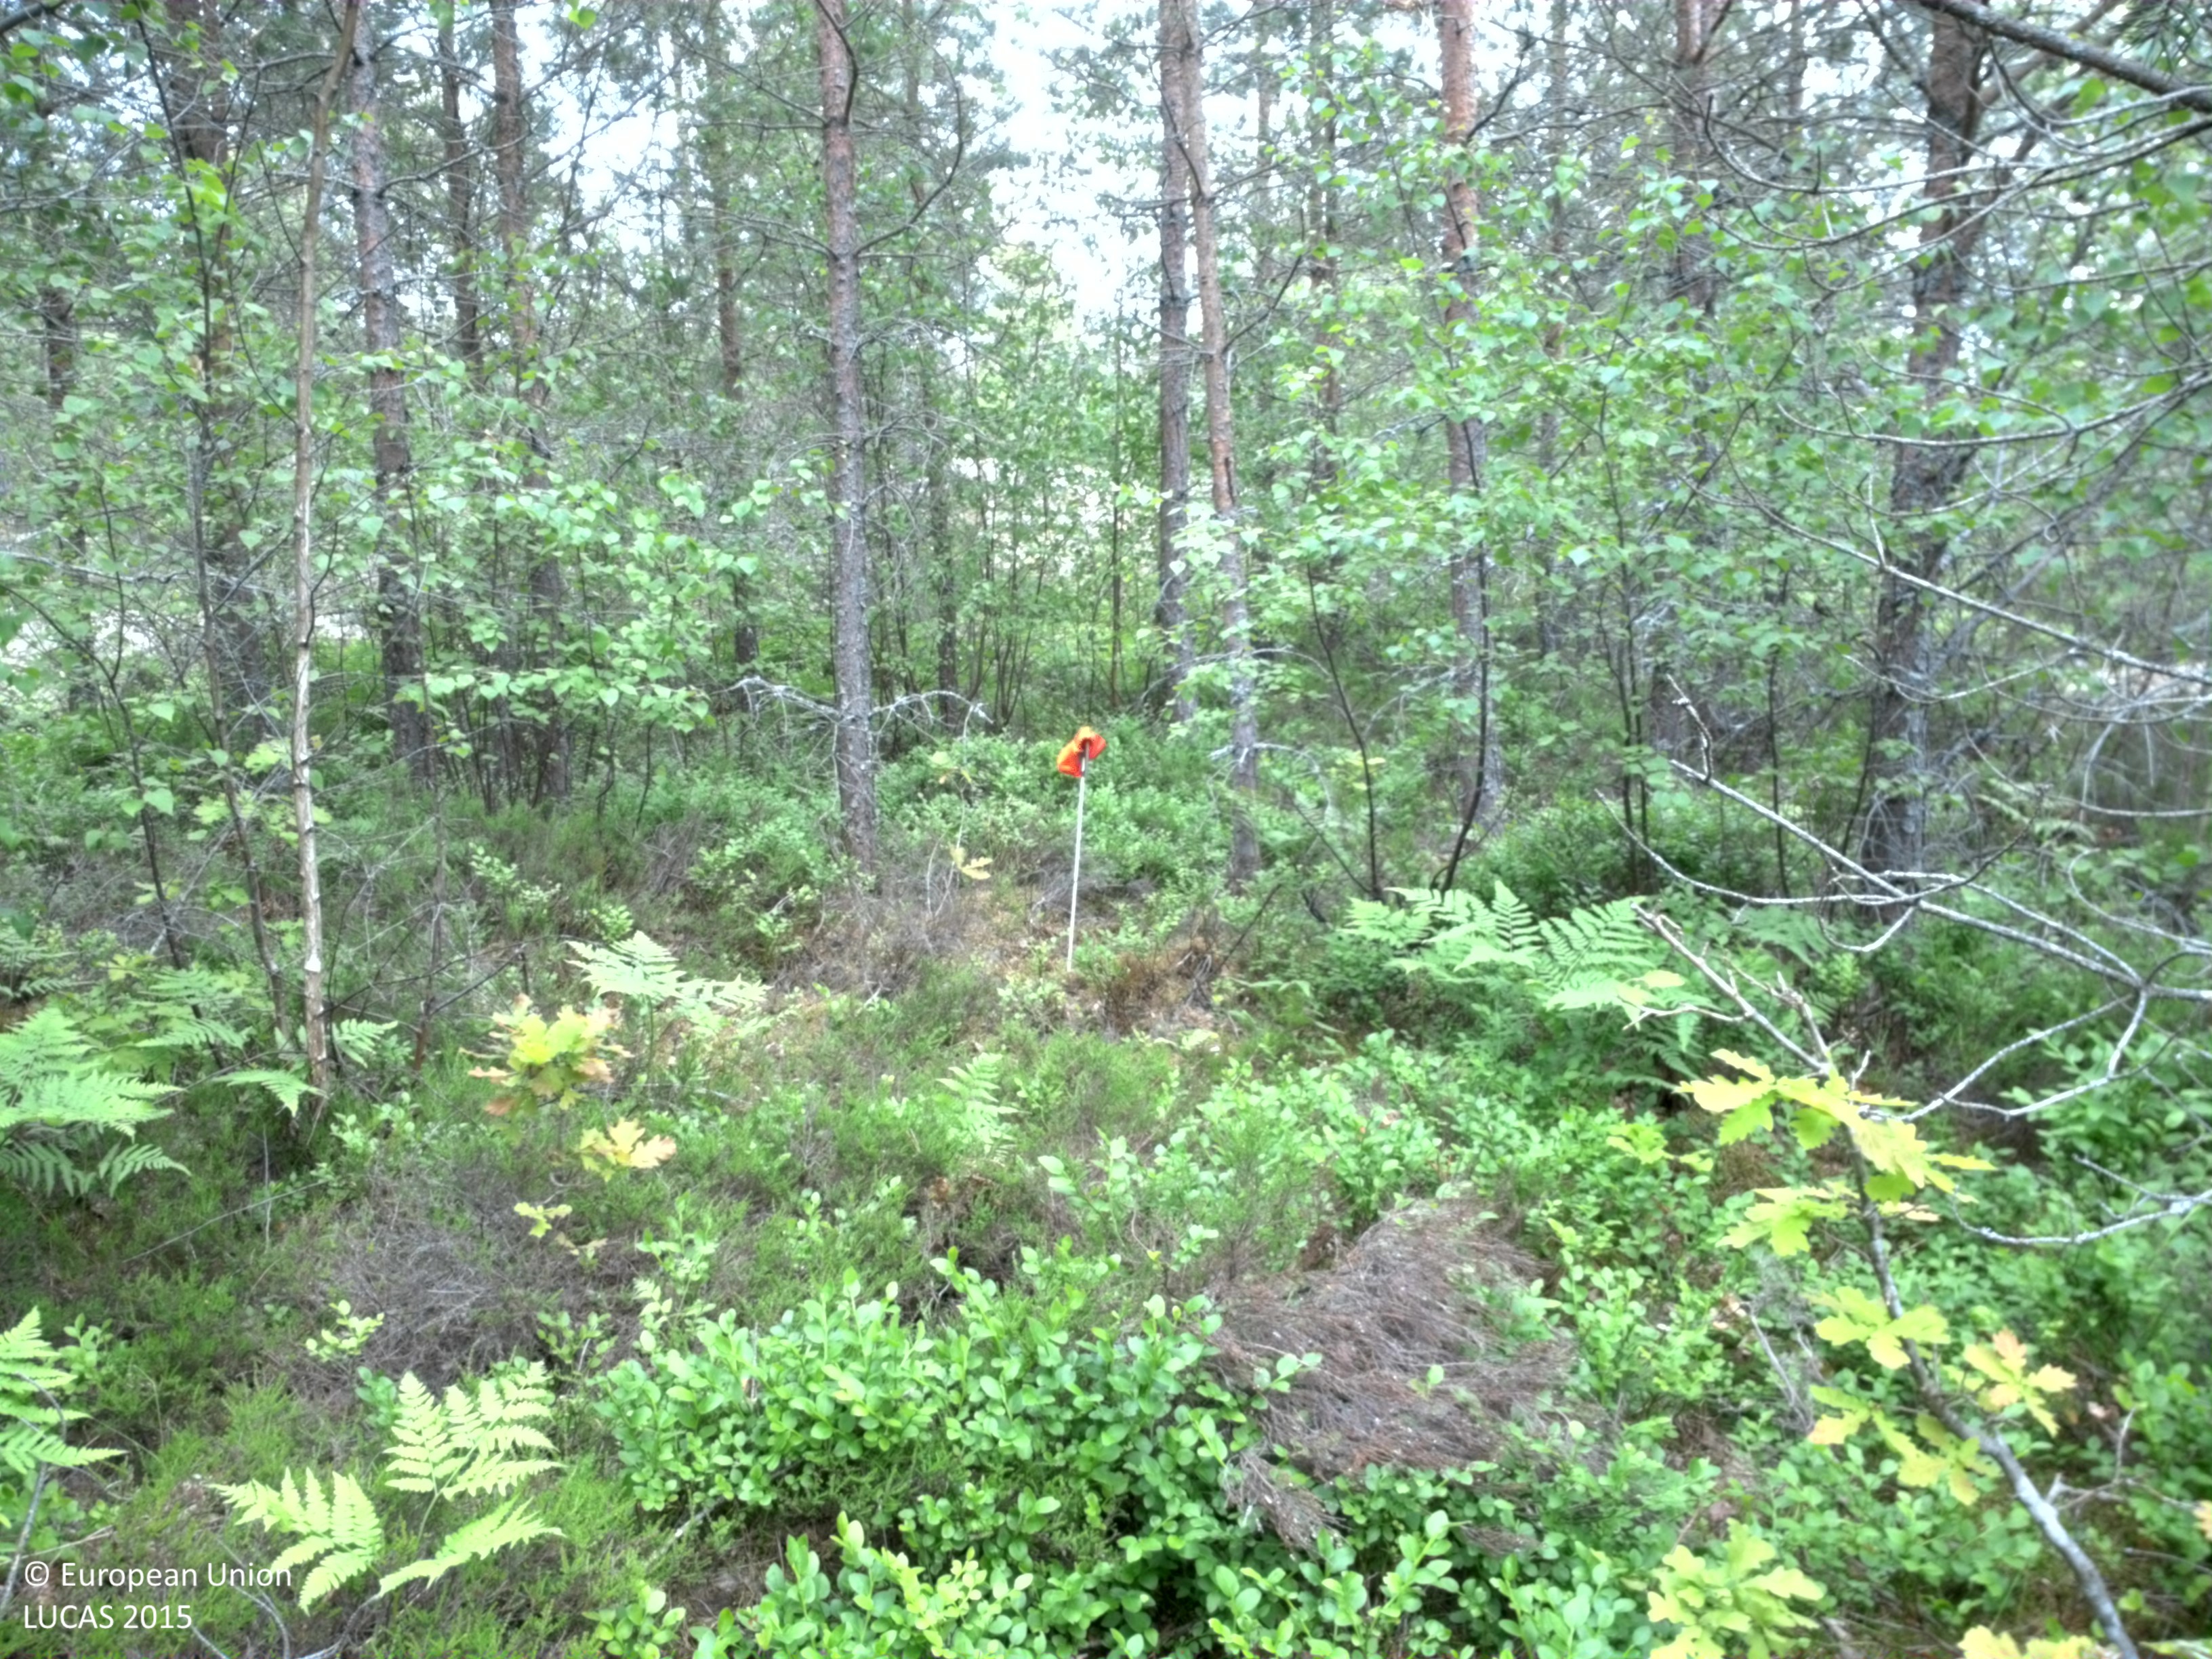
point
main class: Woodland
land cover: Pine dominated mixed woodland
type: boreal forest
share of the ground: 25 - 50 %
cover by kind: herbaceous plants 40 %, coniferous forest trees 30 %, broadleaved forest trees 10 %, shrubs 10 %, lichens and mosses 10 %
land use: Forestry
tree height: < 5 m
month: June
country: SE
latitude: 58.5100
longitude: 16.1916
